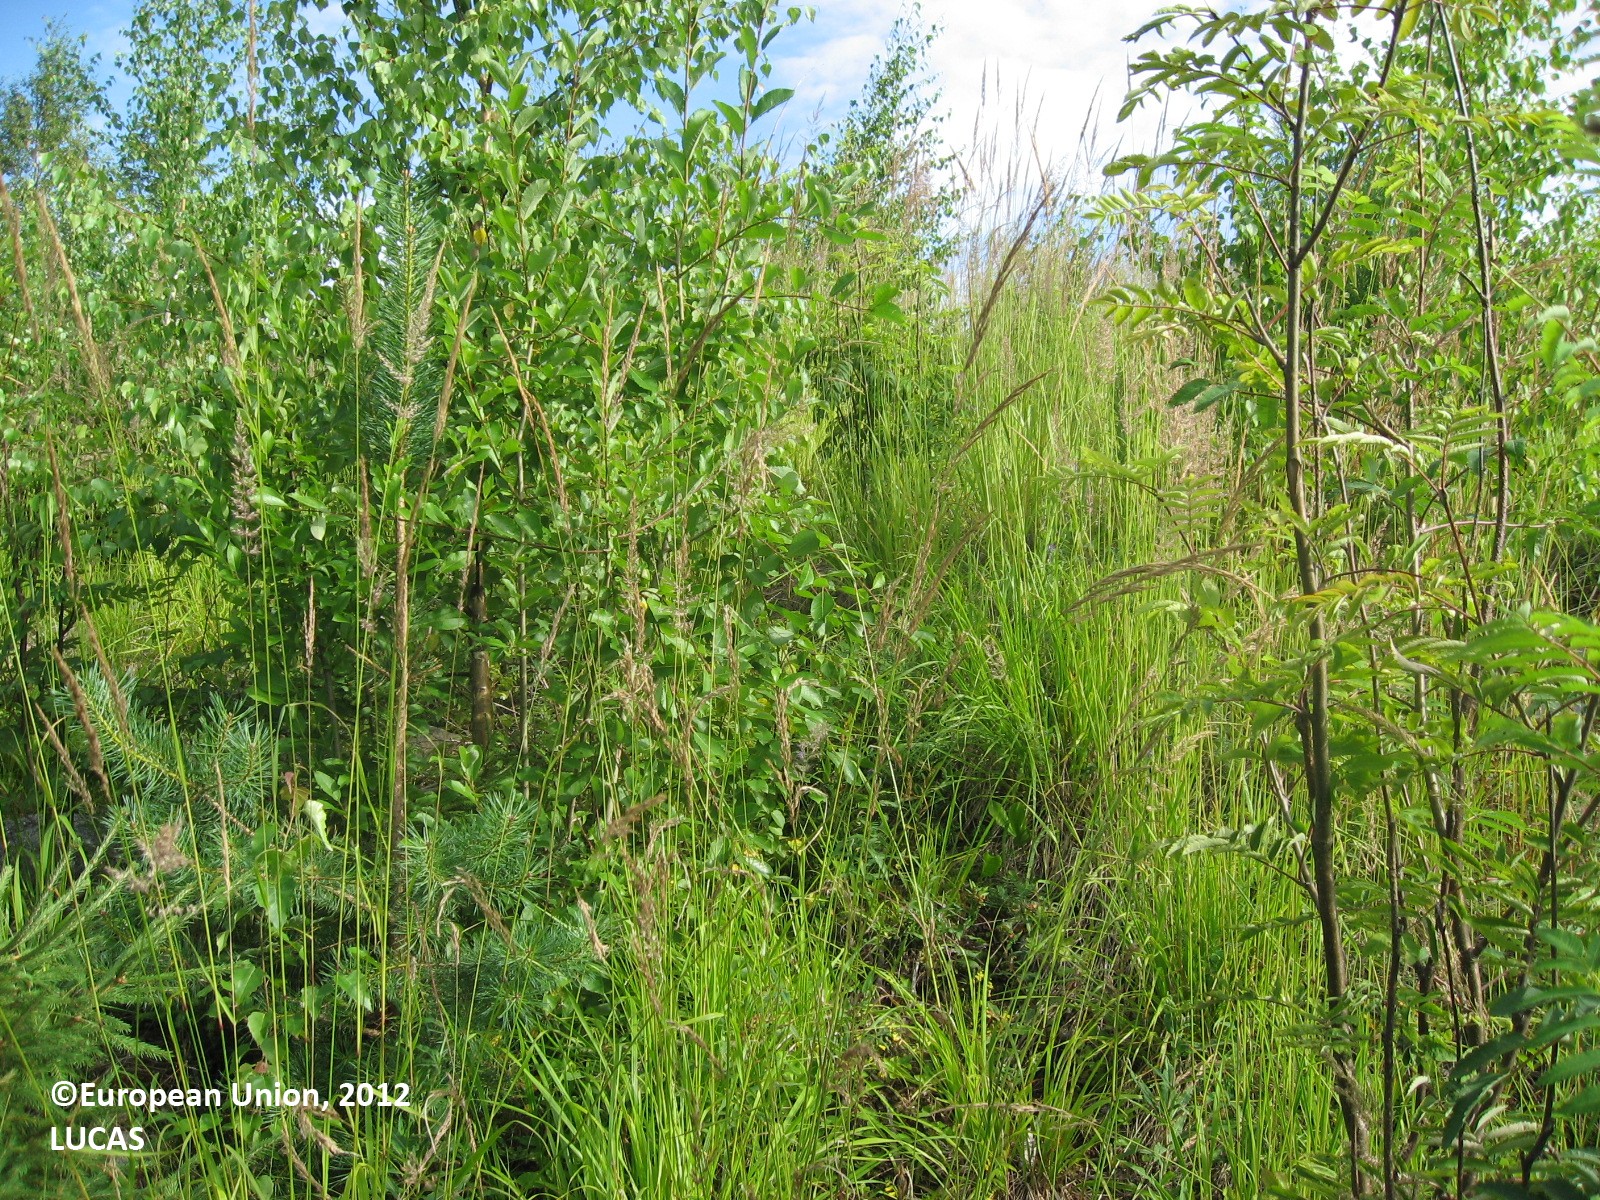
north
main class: Woodland
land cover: Broadleaved woodland
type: boreal forest
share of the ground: 10 - 25 %
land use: Forestry
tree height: < 5 m
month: July
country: FI
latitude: 61.2002
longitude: 25.7801
